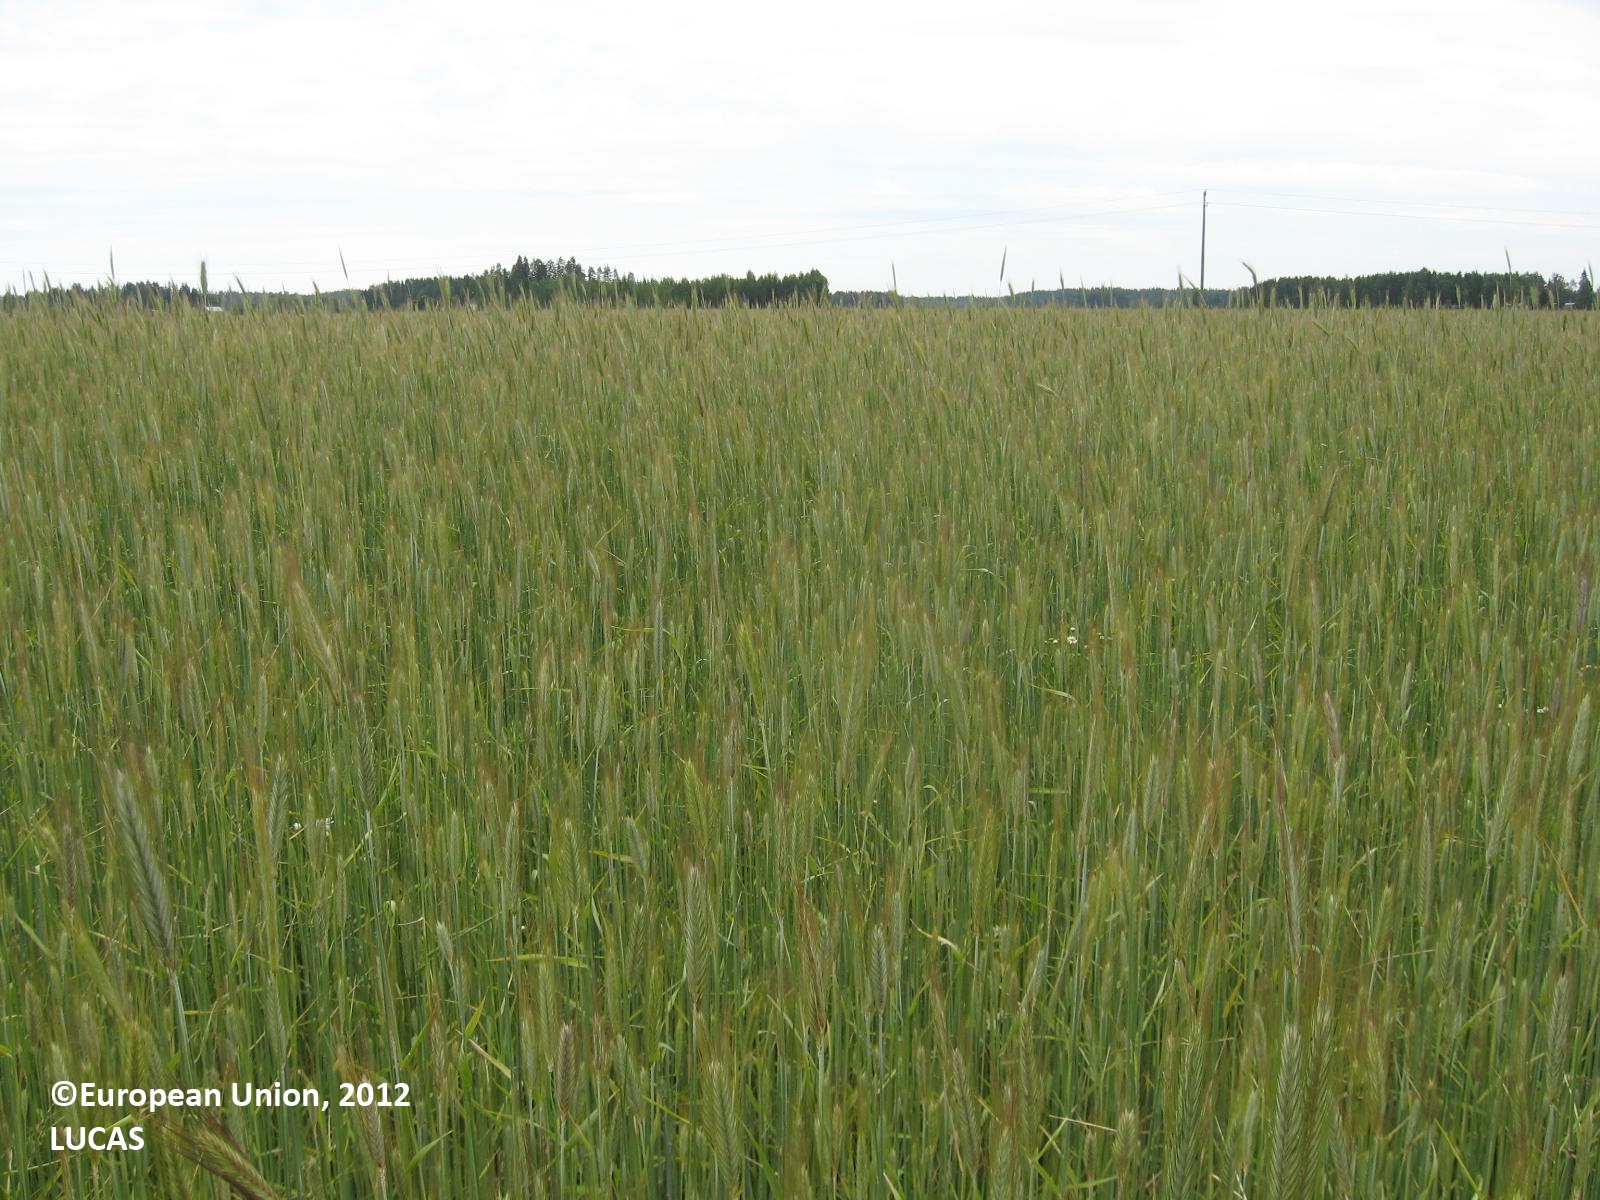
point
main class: Cropland
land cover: Rye
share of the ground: > 75 %
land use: Agriculture (excluding fallow land and kitchen gardens)
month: July
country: FI
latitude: 62.4773
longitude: 22.8834
